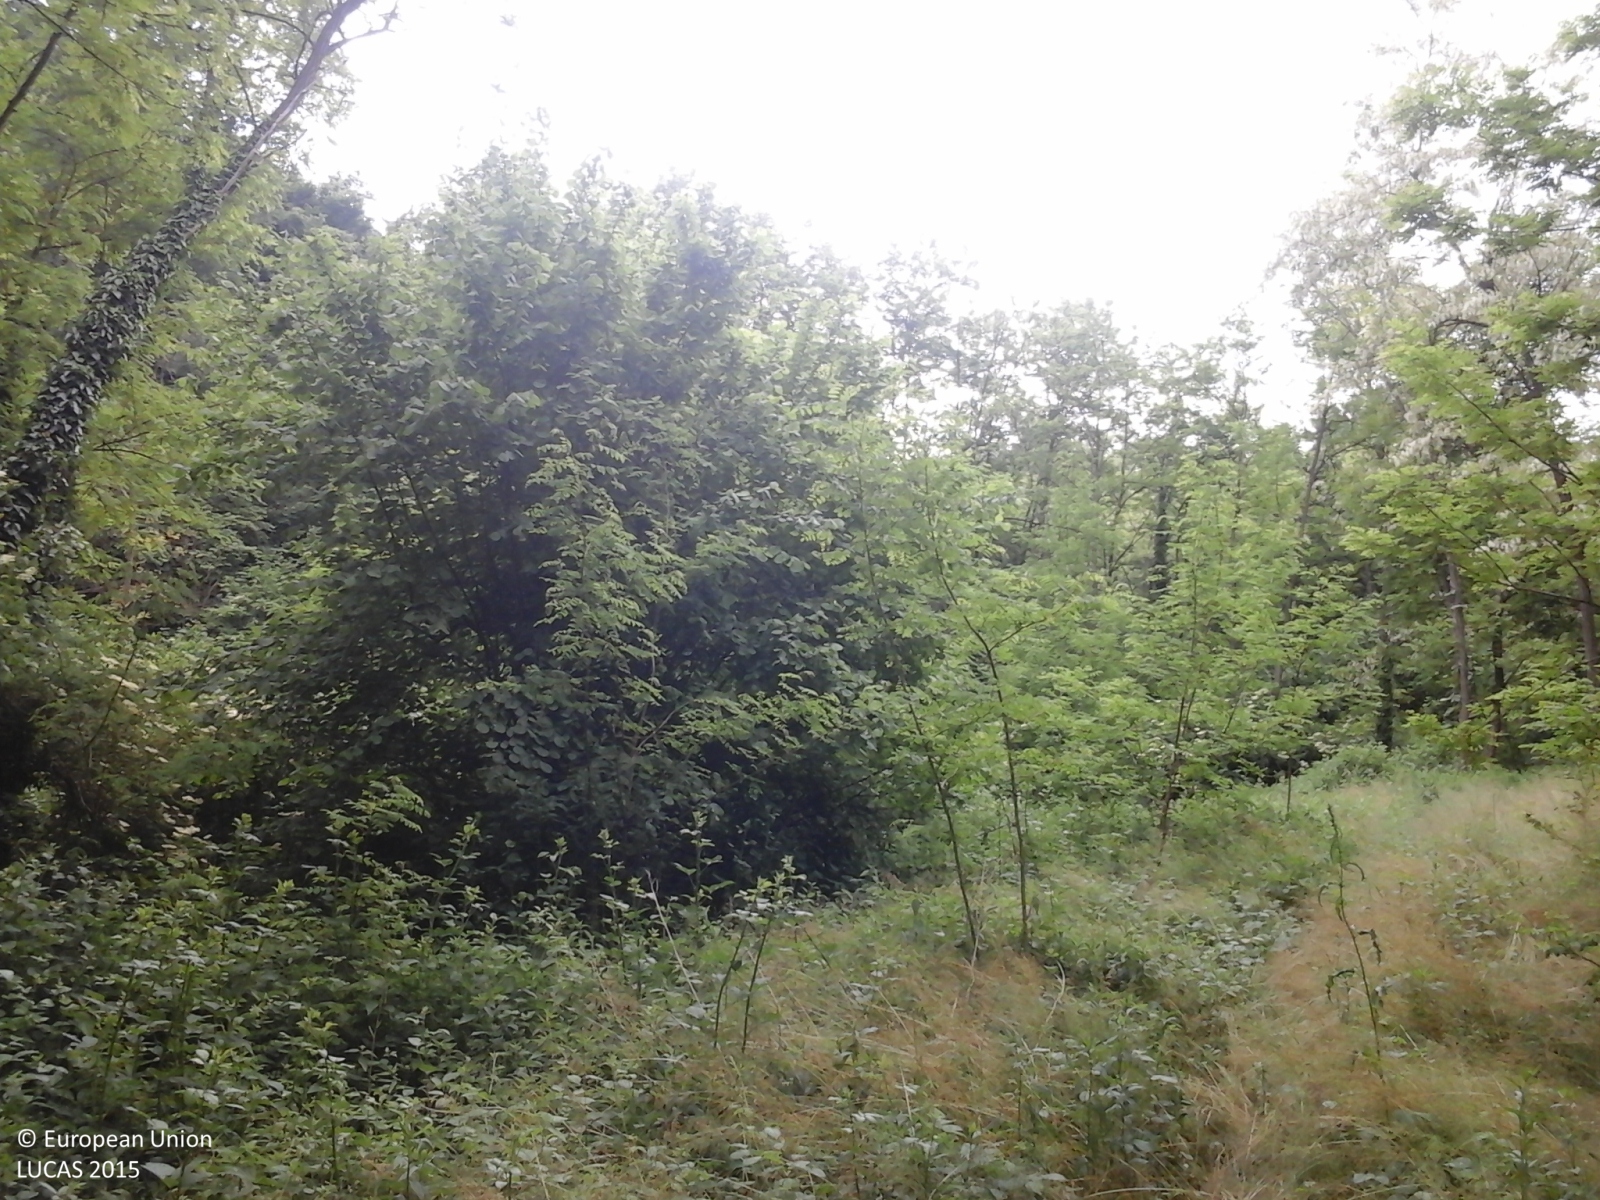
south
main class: Woodland
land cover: Broadleaved woodland
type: thermophilous deciduous forest
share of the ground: > 75 %
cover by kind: broadleaved forest trees 85 %, shrubs 10 %, herbaceous plants 5 %
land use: Forestry
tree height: > 5 m
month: May
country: IT
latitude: 44.8420
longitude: 8.3207
